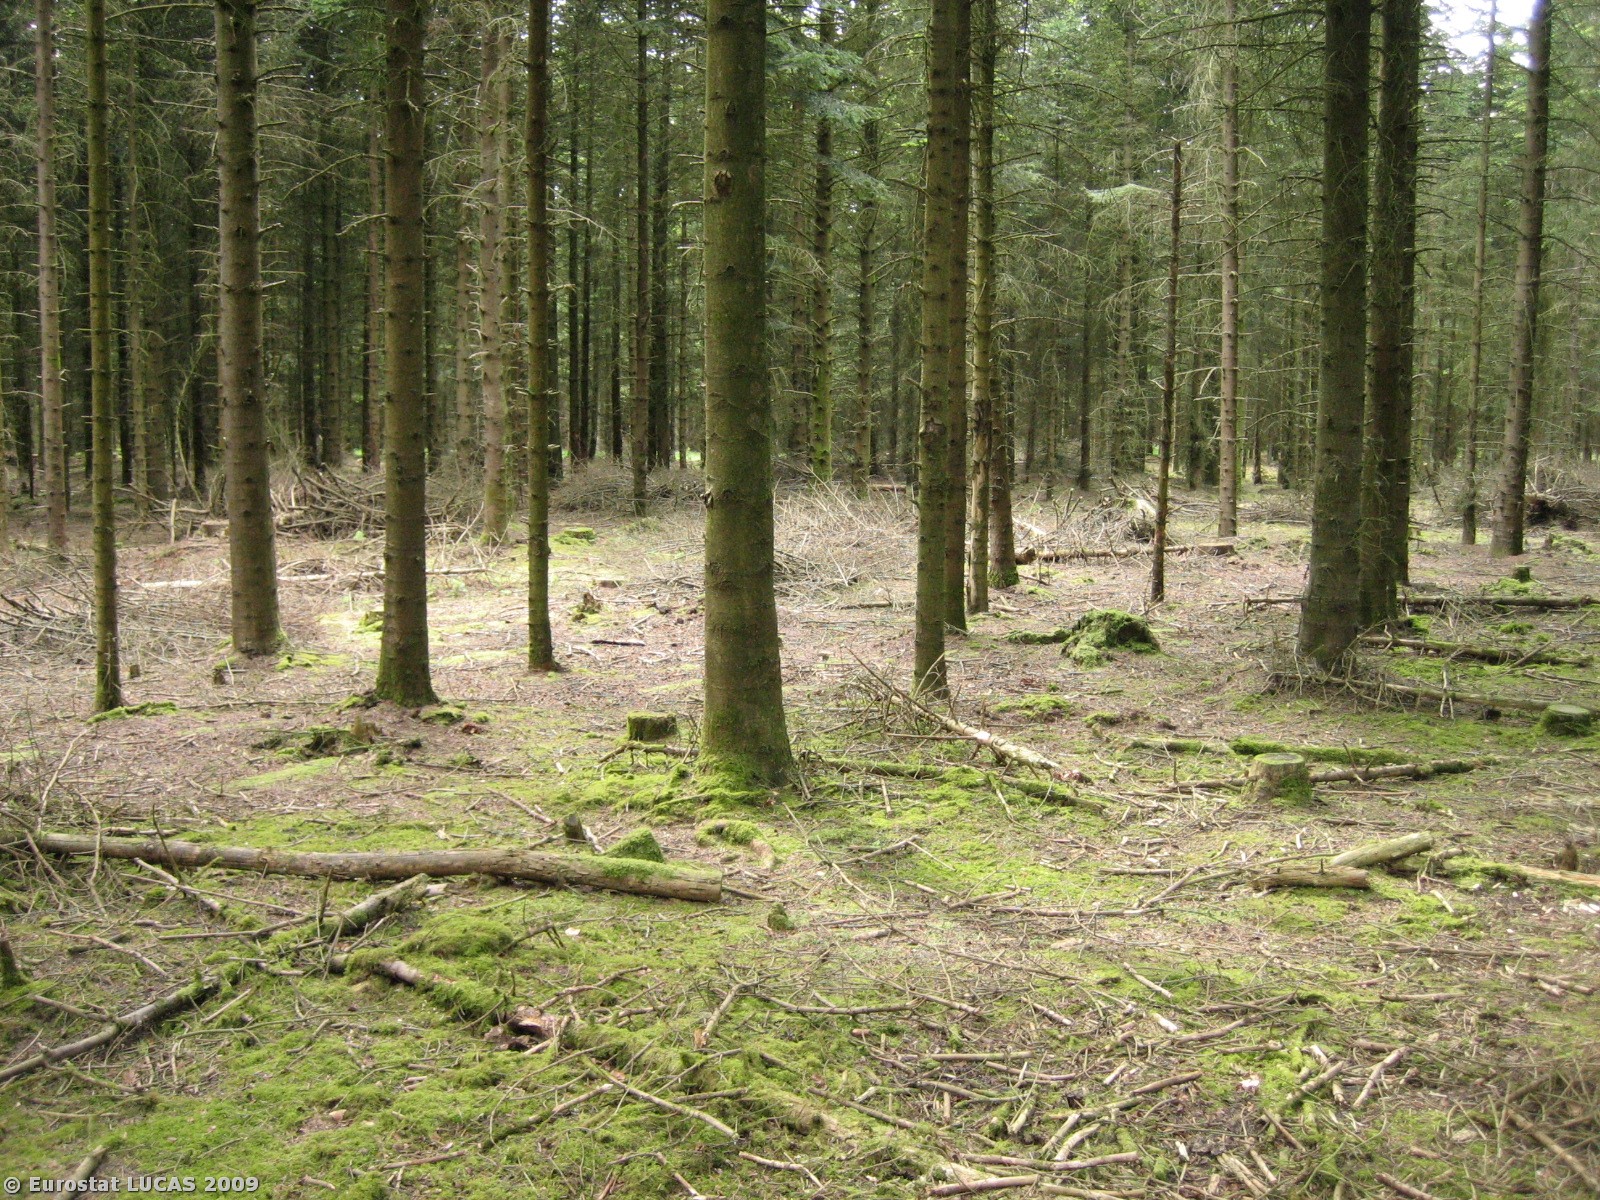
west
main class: Woodland
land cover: Coniferous woodland
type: hemiboreal forest and nemoral coniferous forest and mixed broadleaved-coniferous forest
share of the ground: > 75 %
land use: Forestry
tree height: > 5 m
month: May
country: DK
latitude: 56.1599
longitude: 8.4077
